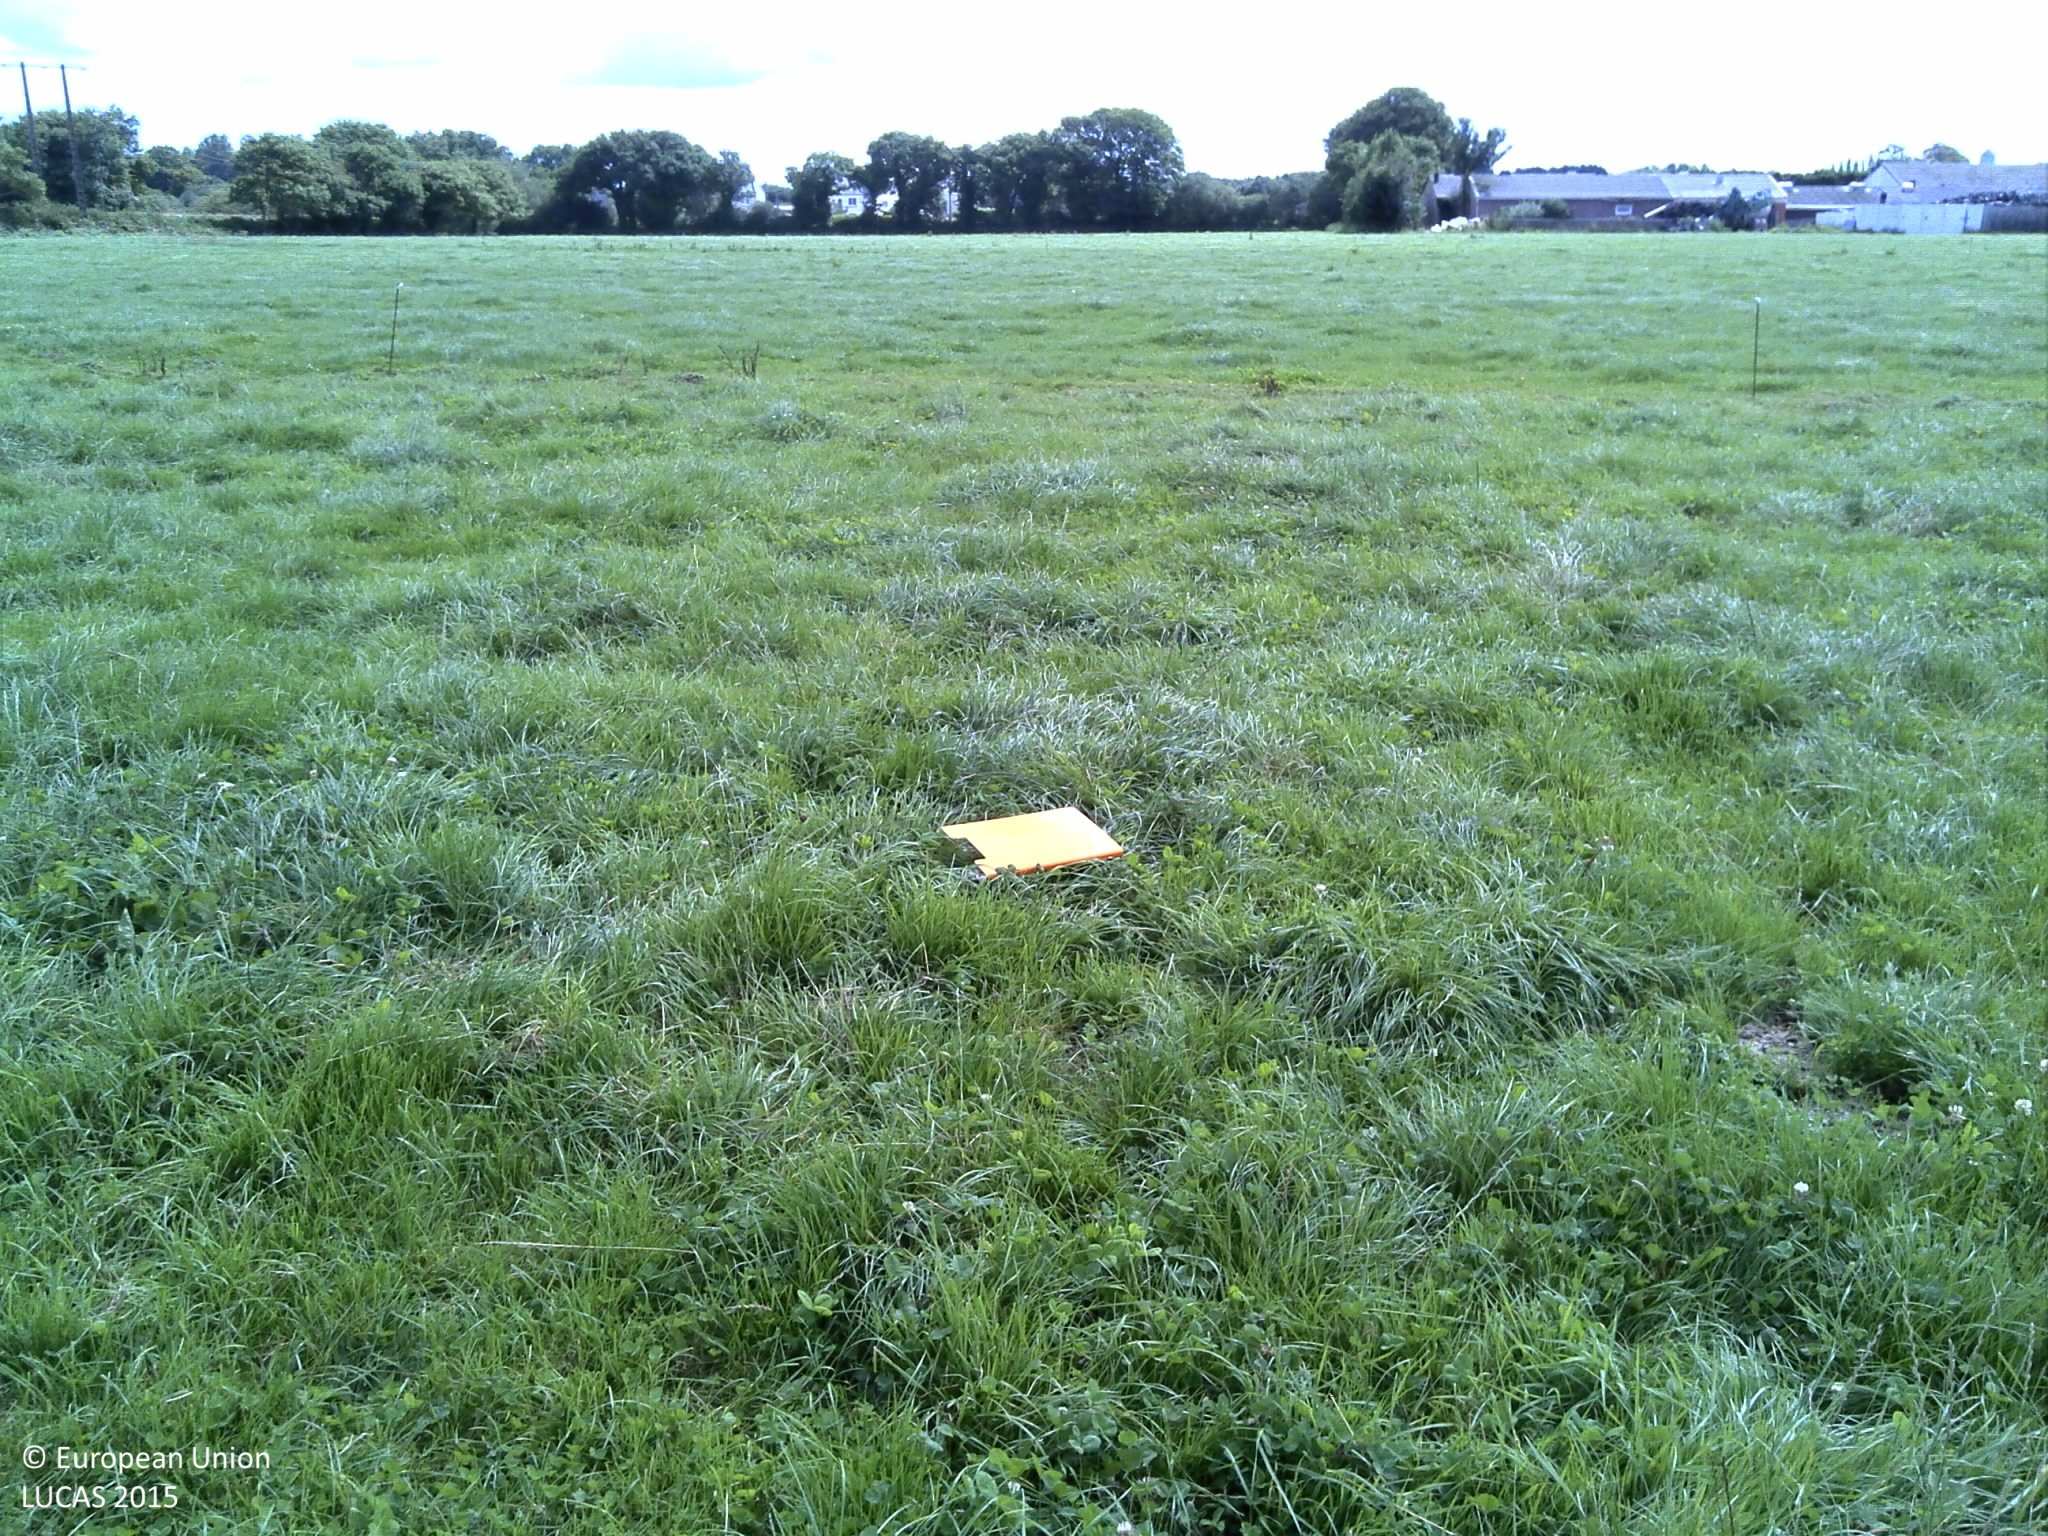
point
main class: Grassland
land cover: Grassland without tree/shrub cover
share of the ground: > 75 %
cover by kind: herbaceous plants 100 %
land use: Agriculture (excluding fallow land and kitchen gardens)
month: September
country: FR
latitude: 48.5205
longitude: -4.2145
